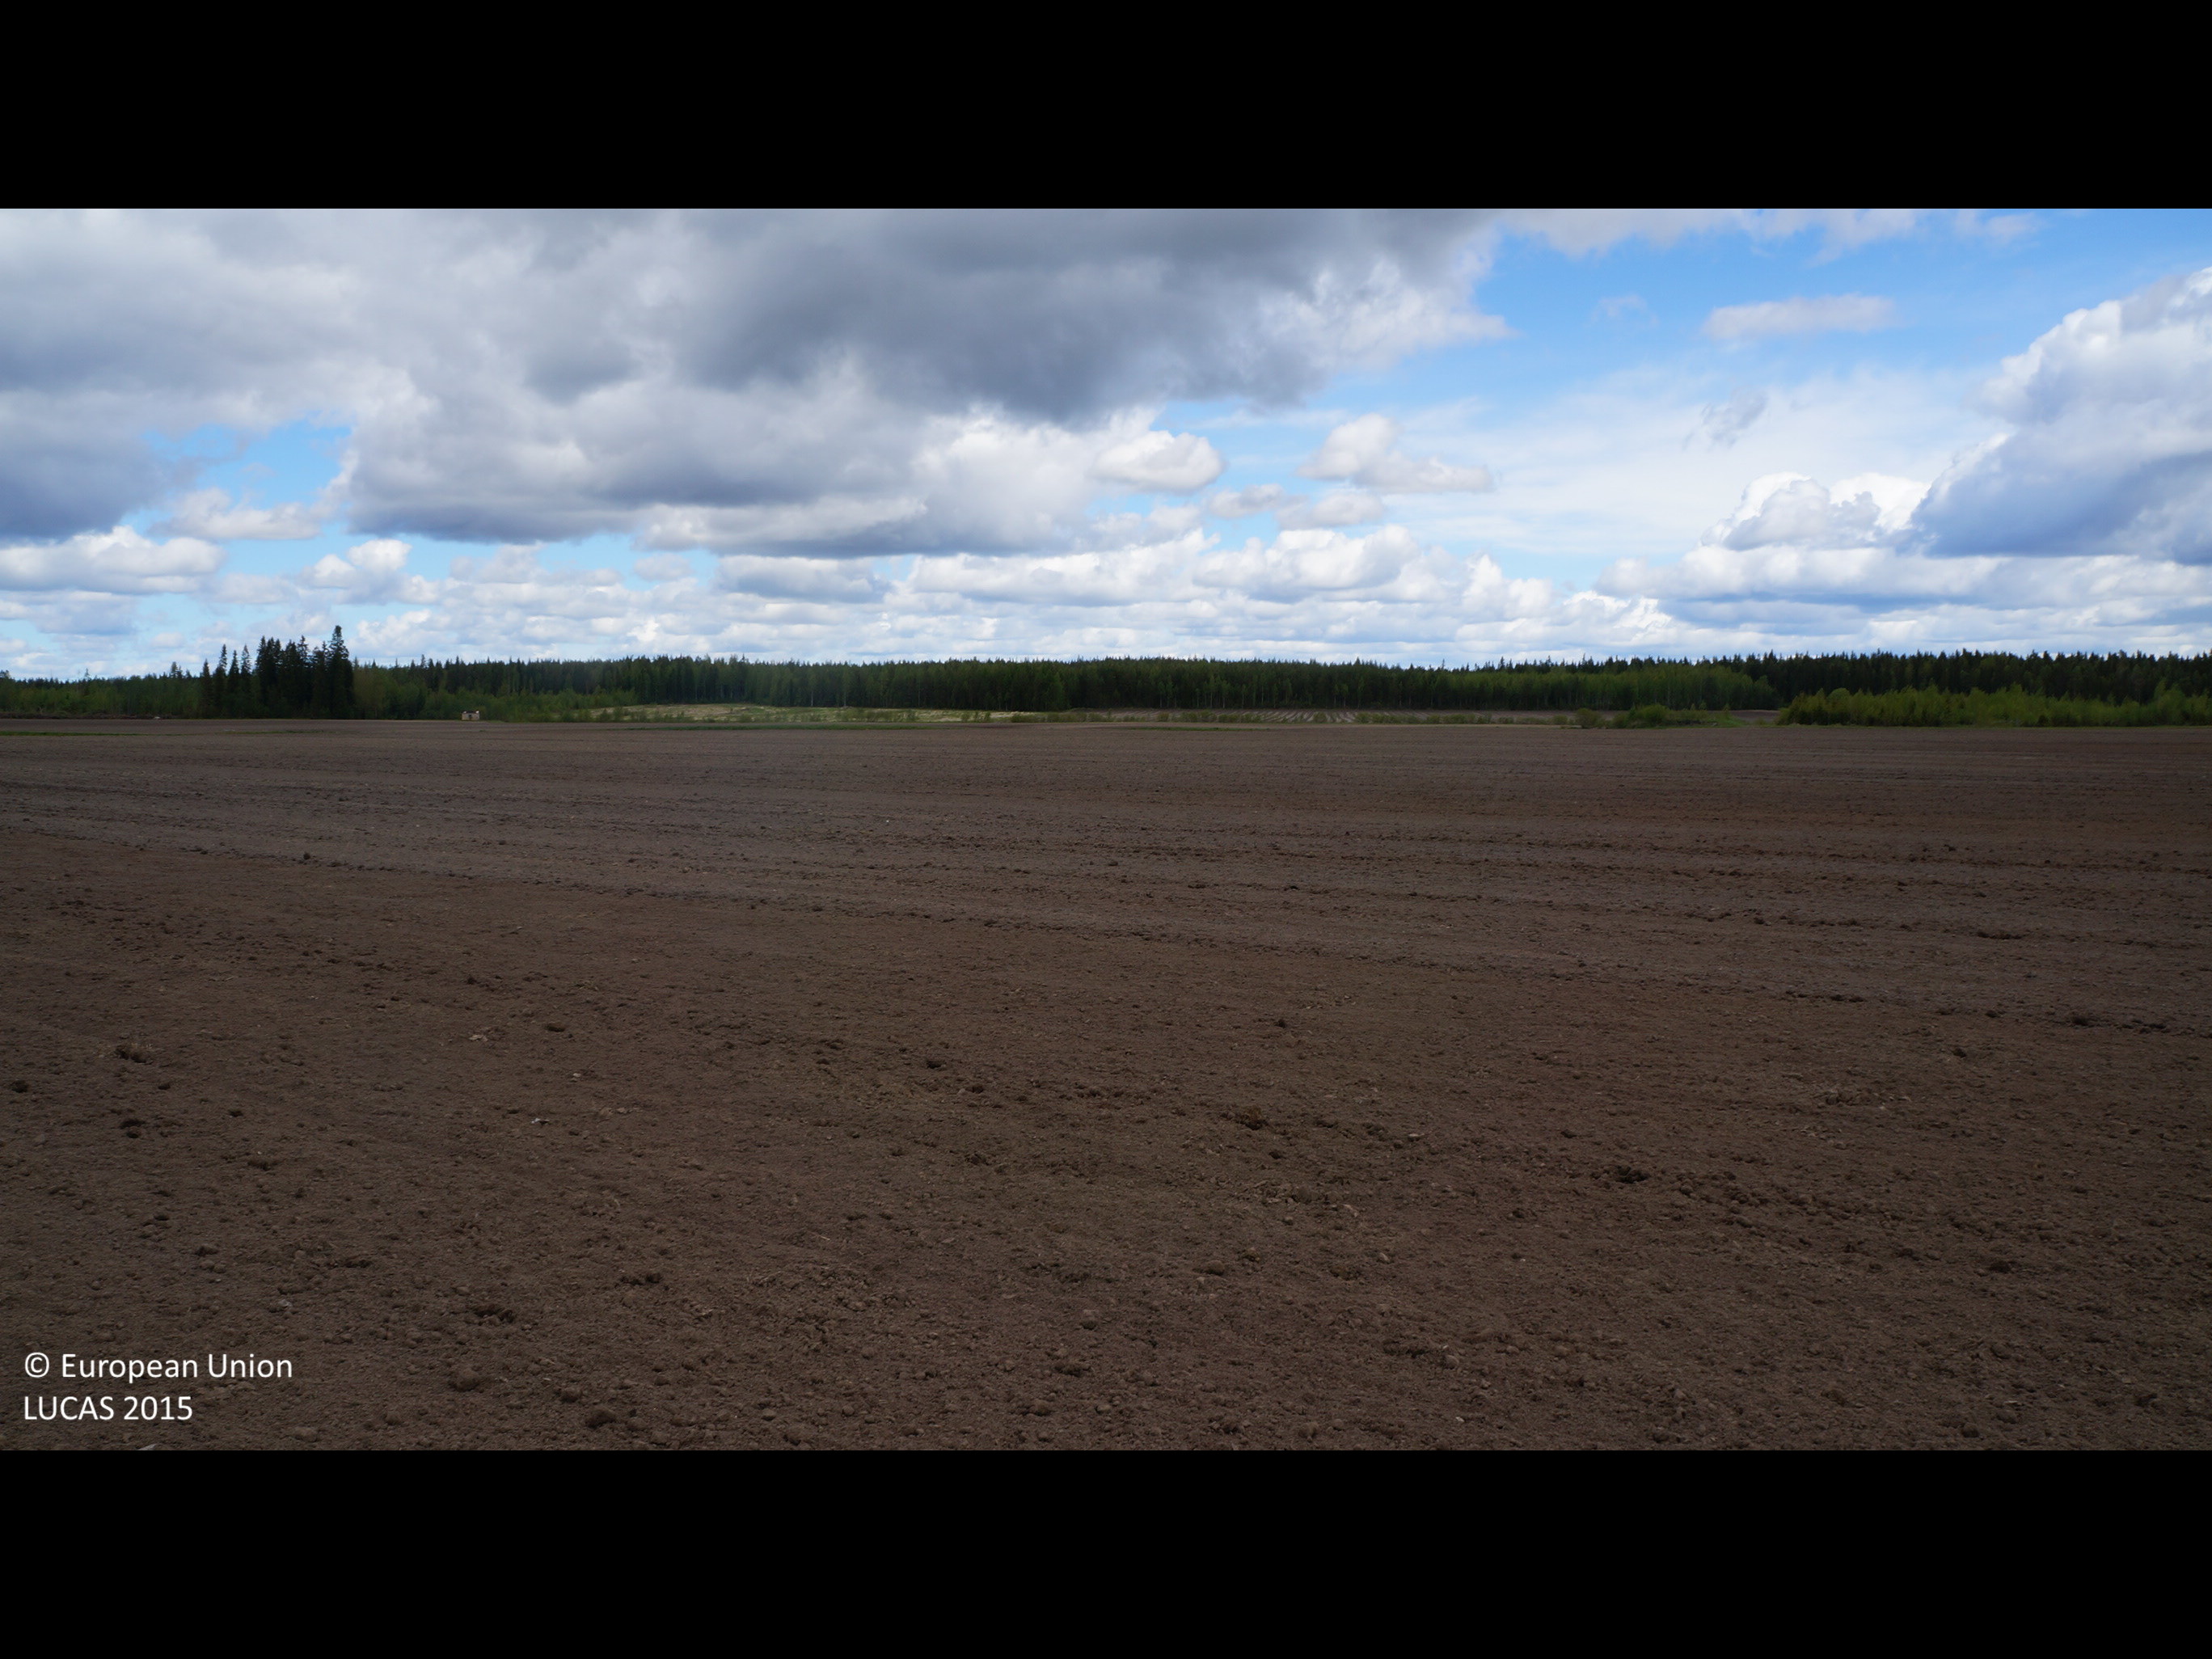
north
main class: Cropland
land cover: Barley
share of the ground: < 10 %
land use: Agriculture (excluding fallow land and kitchen gardens)
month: June
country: FI
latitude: 63.7129
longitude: 24.2603
